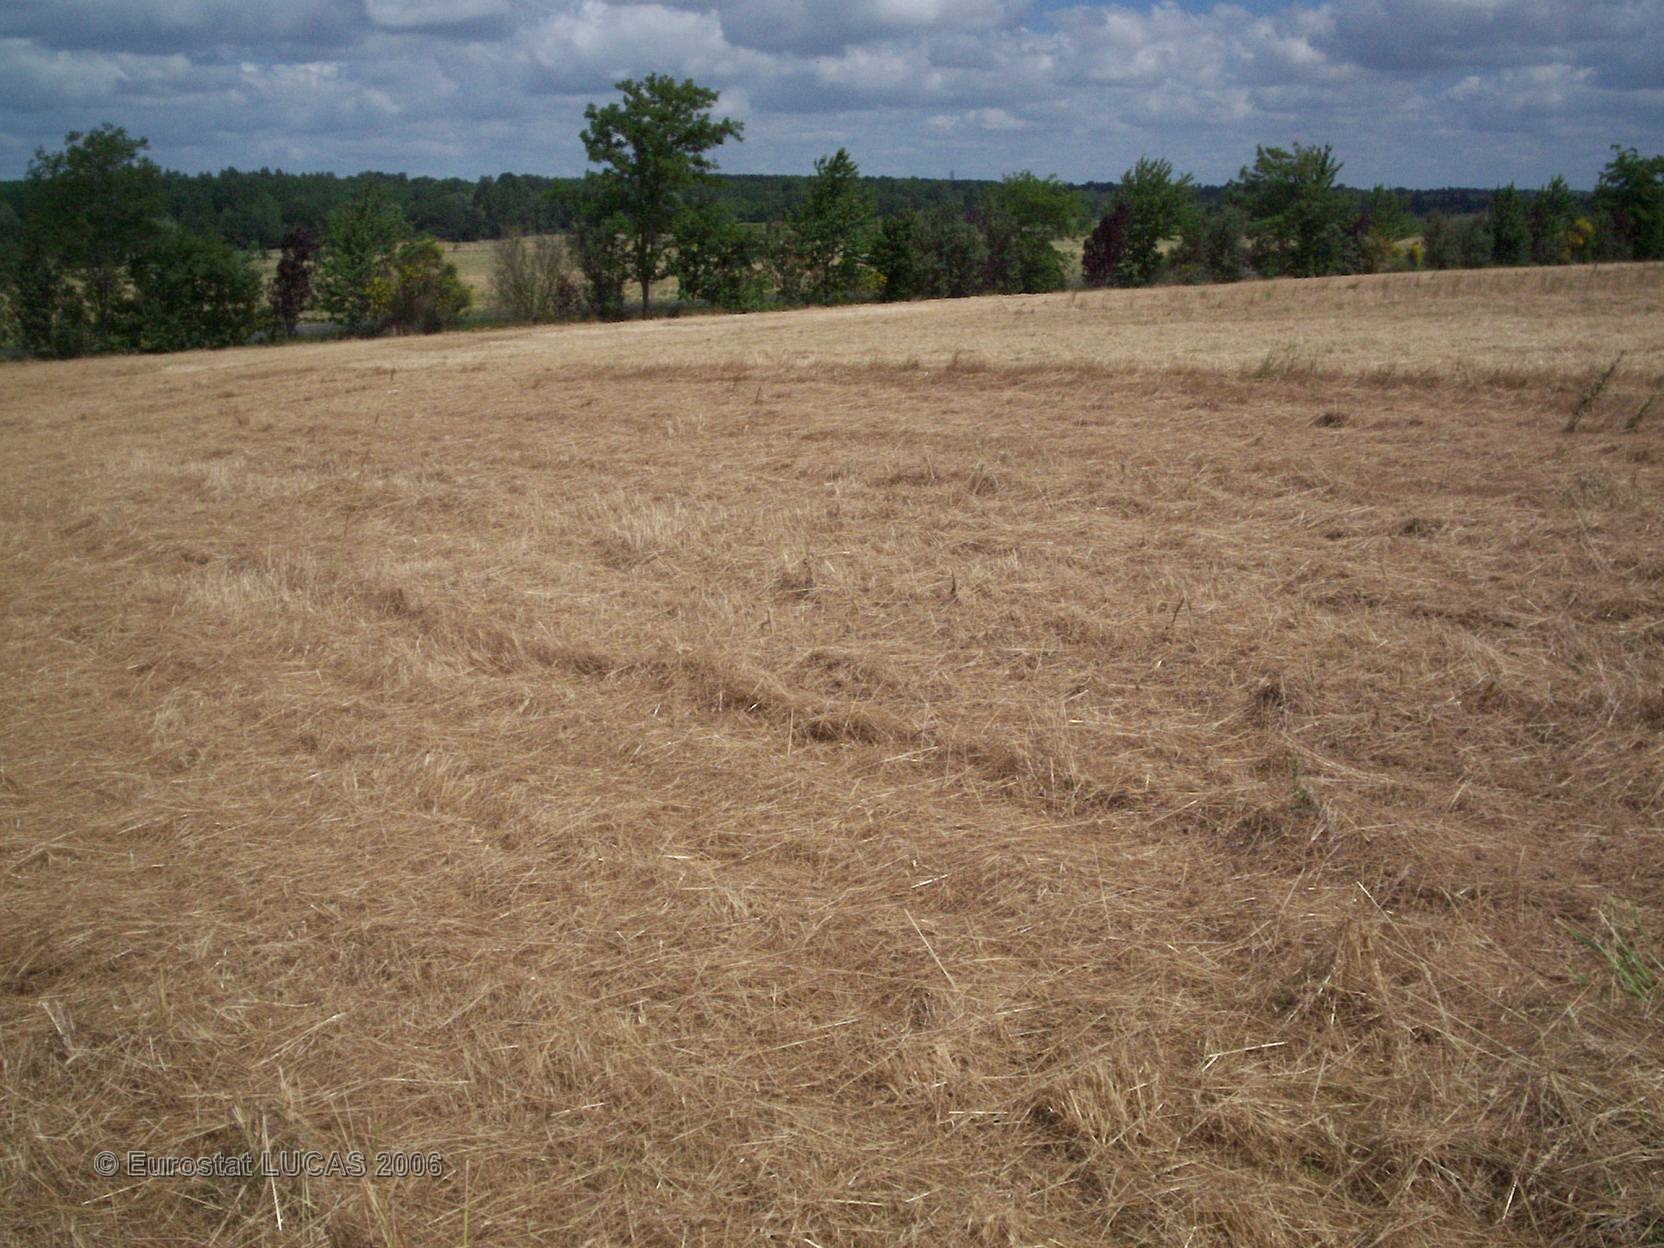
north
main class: Grassland
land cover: Grassland without tree/shrub cover
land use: Agriculture (excluding fallow land and kitchen gardens)
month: May
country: FR
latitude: 43.5418
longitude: 1.0034
